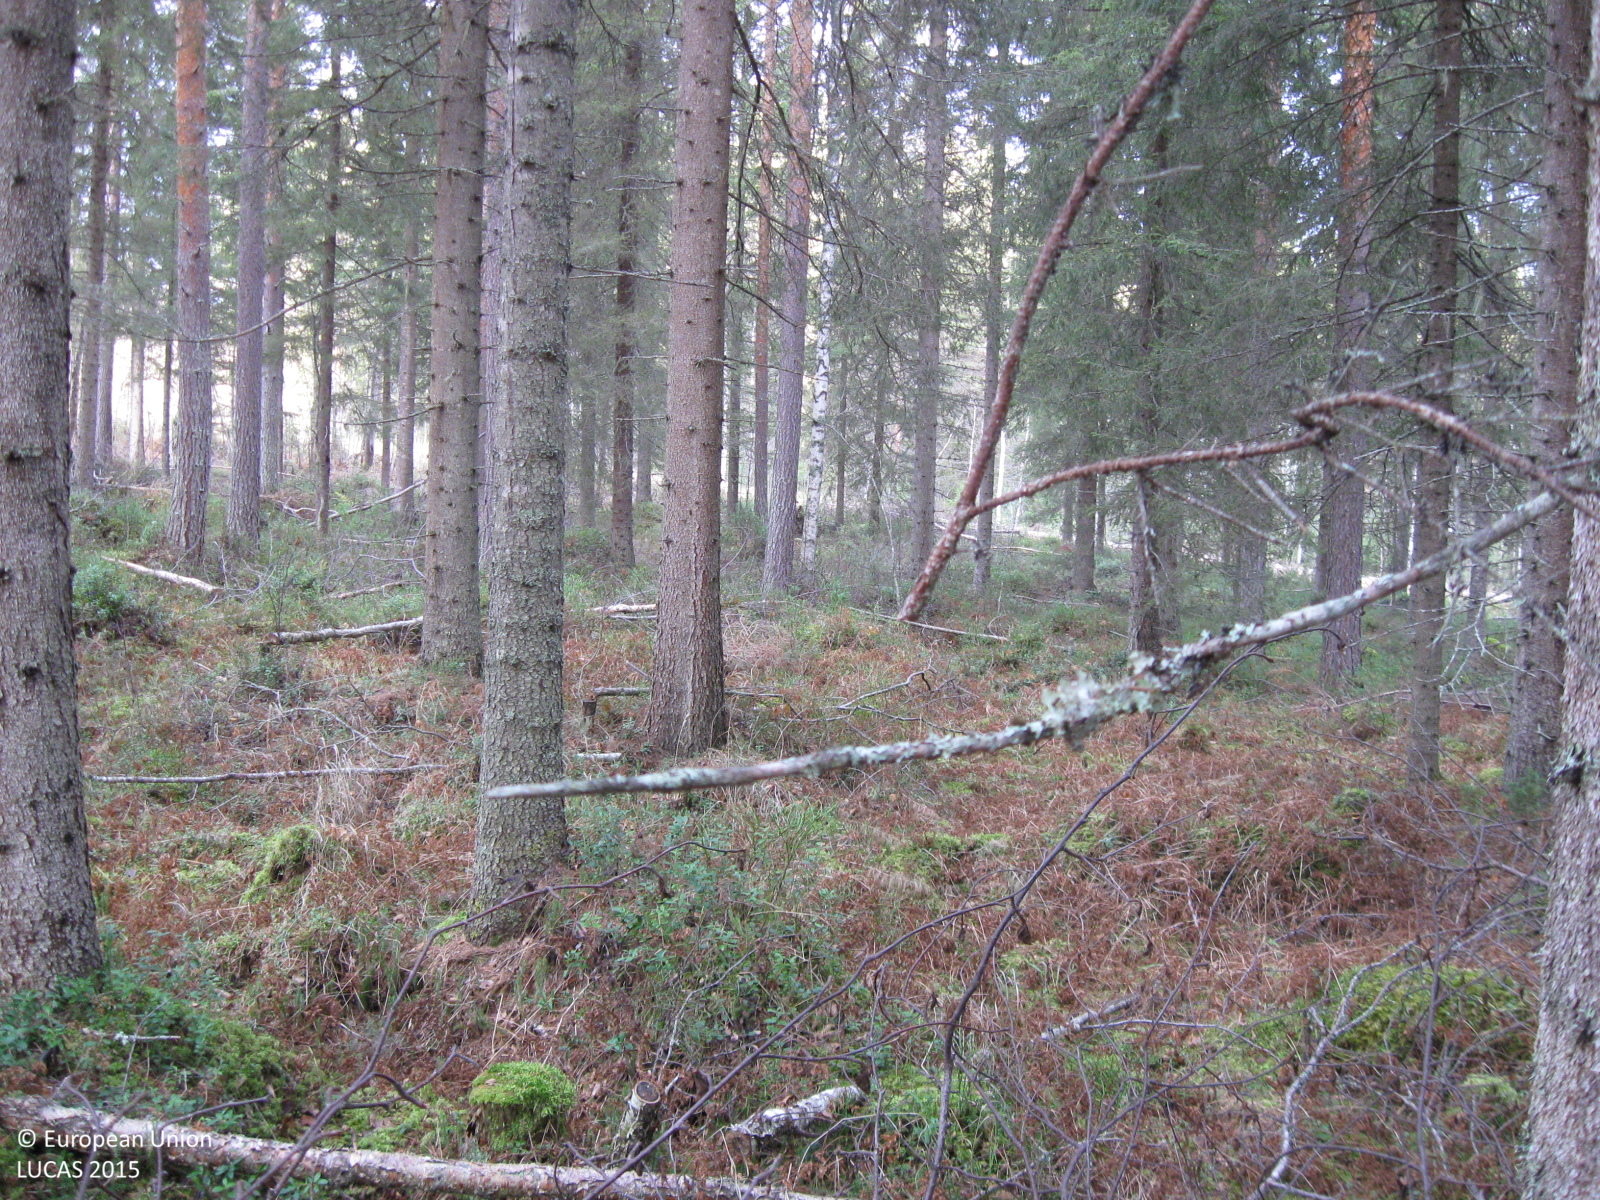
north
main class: Woodland
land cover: Spruce dominated coniferous woodland
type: boreal forest
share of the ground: > 75 %
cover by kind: coniferous forest trees 80 %, broadleaved forest trees 5 %, shrubs 5 %, herbaceous plants 5 %, lichens and mosses 5 %
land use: Forestry
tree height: > 5 m
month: November
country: SE
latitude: 66.0888
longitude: 20.5963
